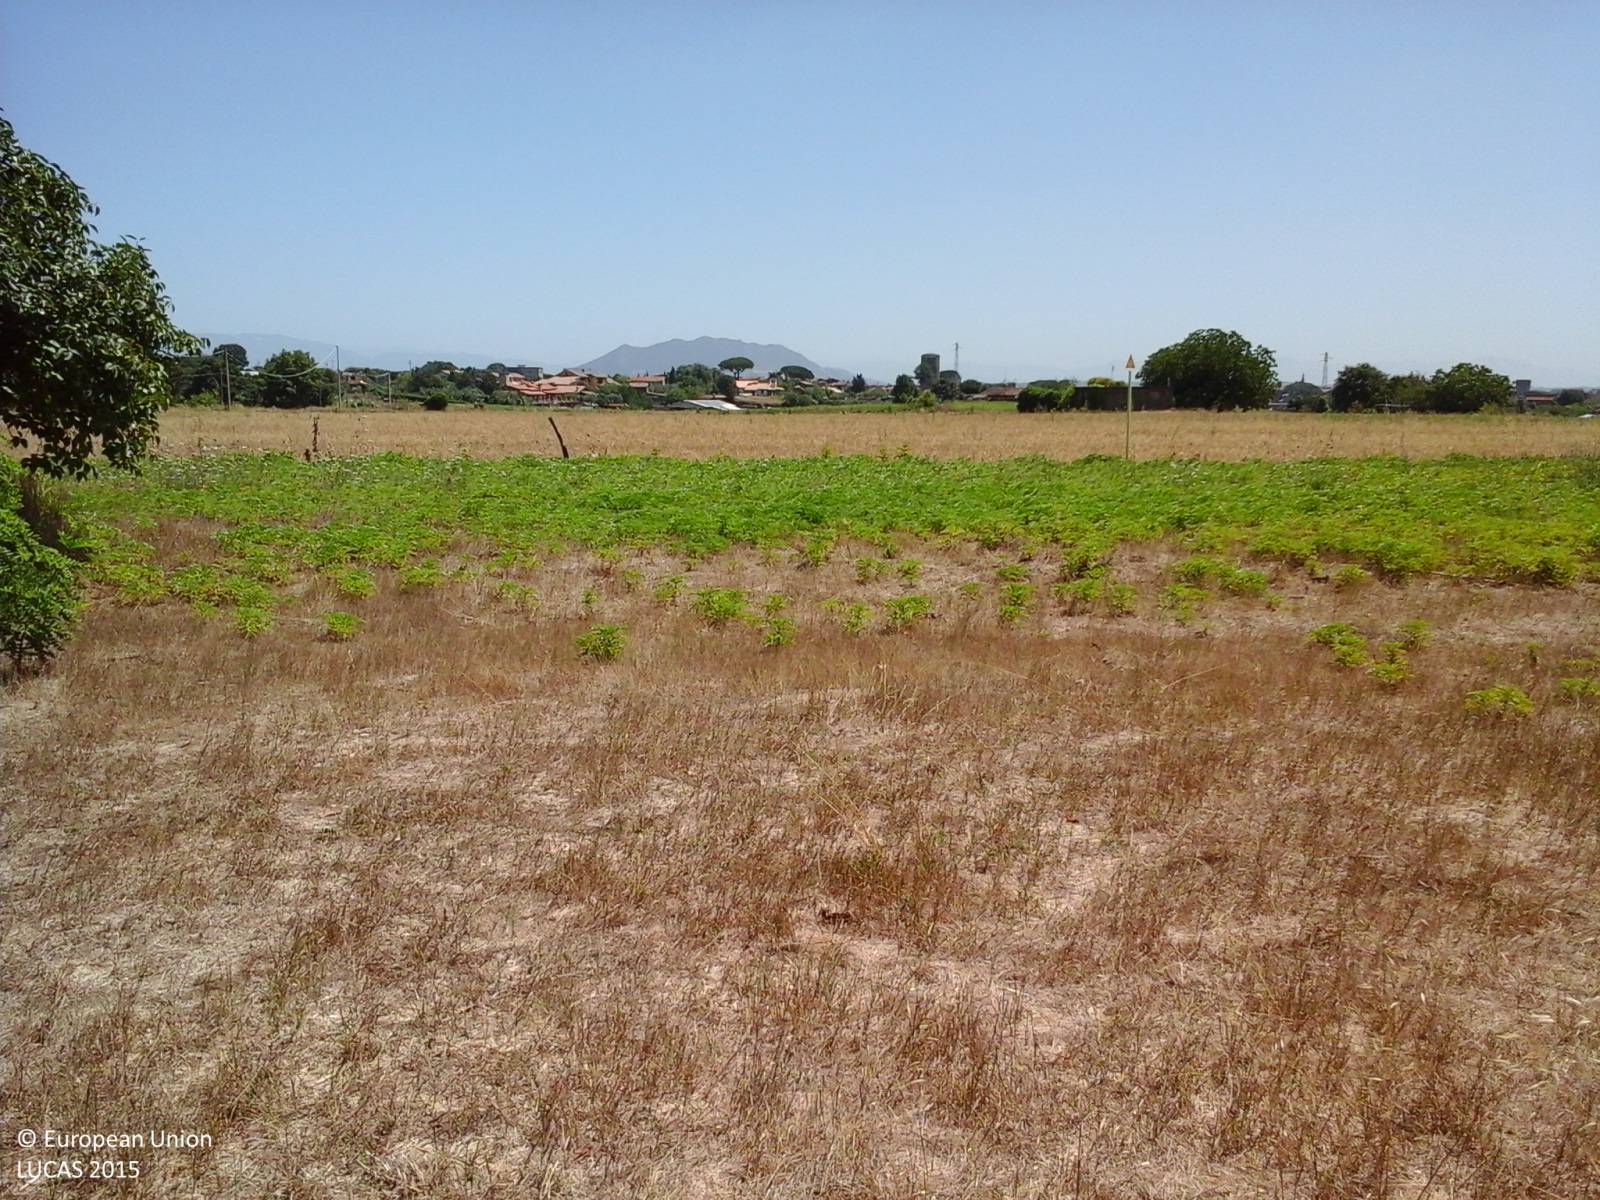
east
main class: Grassland
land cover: Grassland with sparse tree/shrub cover
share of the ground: > 75 %
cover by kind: herbaceous plants 95 %, broadleaved forest trees 5 %
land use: Abandoned areas
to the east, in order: Grassland with sparse tree/shrub cover; Common wheat; Tracks; Other bare soil; Durum wheat
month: July
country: IT
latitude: 42.2477
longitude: 12.3310
